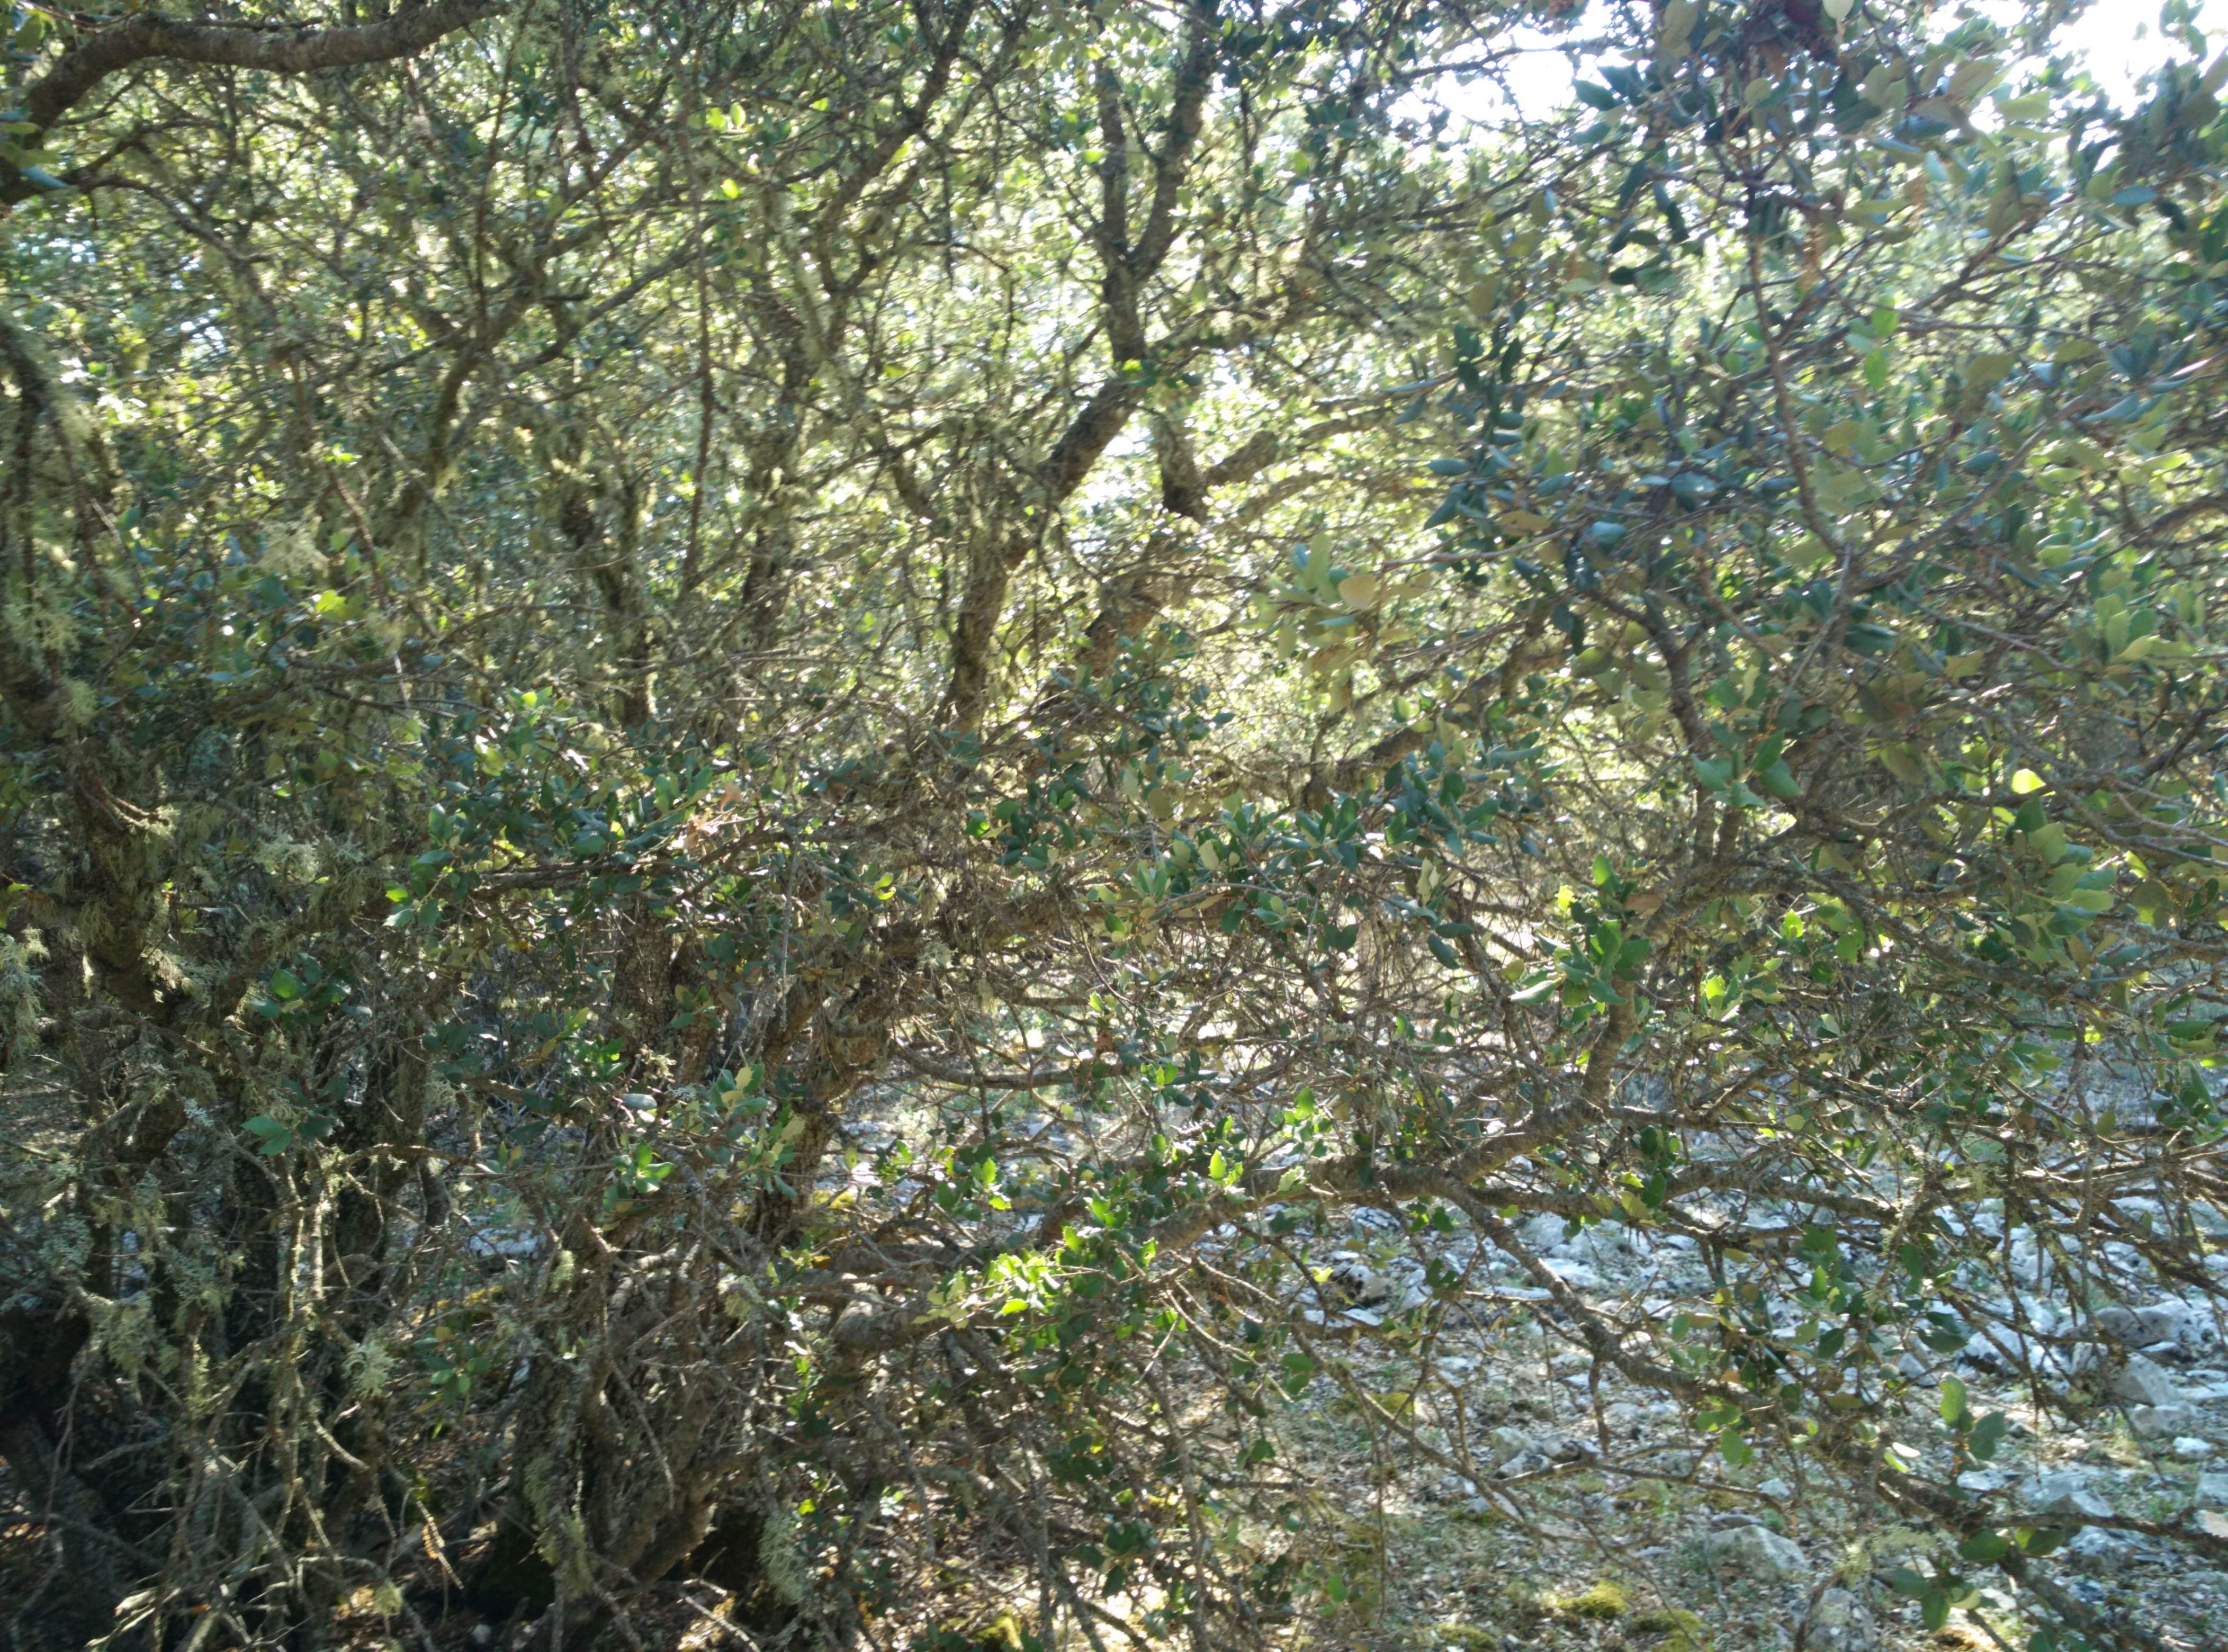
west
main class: Woodland
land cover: Broadleaved woodland
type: broadleaved evergreen forest
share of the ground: 50 - 75 %
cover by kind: broadleaved forest trees 65 %, unconsolidated bare surface 25 %, shrubs 5 %, herbaceous plants 5 %
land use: Semi-natural and natural areas not in use
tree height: > 5 m
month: June
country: ES
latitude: 40.7184
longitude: -1.8230
